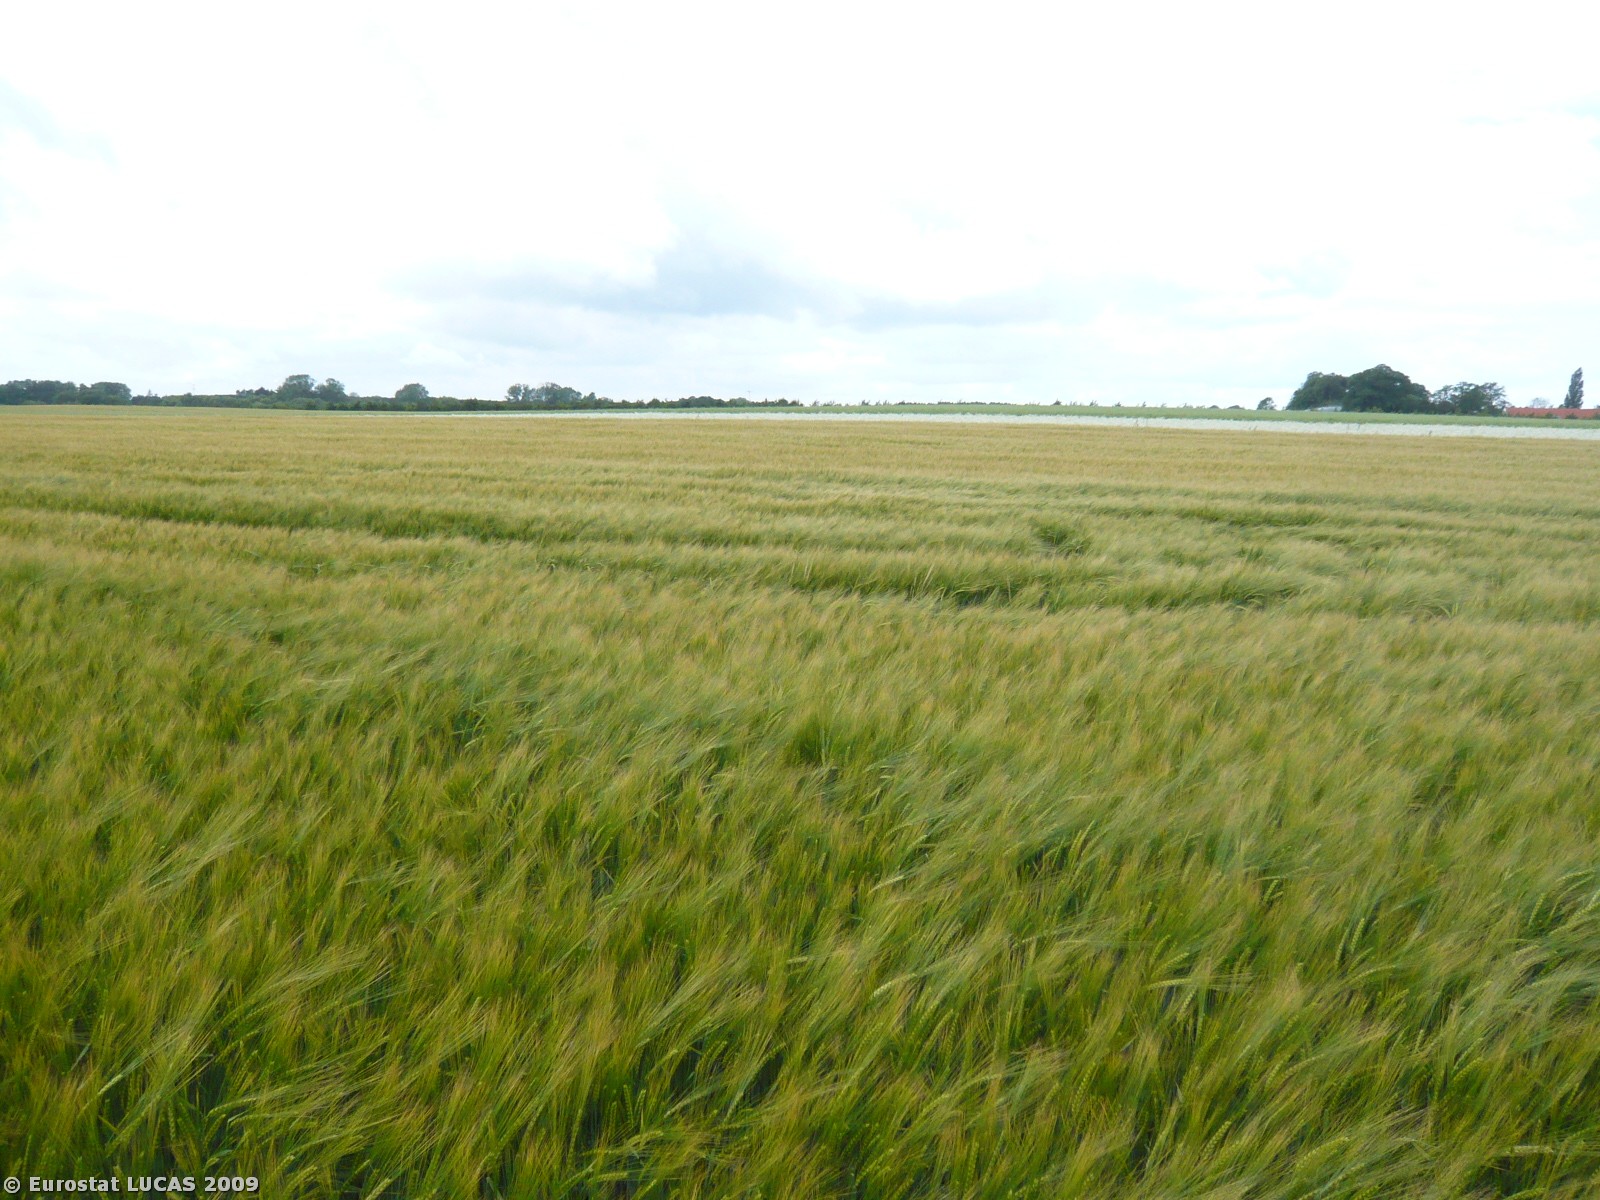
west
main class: Cropland
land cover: Barley
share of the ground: > 75 %
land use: Agriculture (excluding fallow land and kitchen gardens)
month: July
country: DK
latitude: 55.3904
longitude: 11.2776
